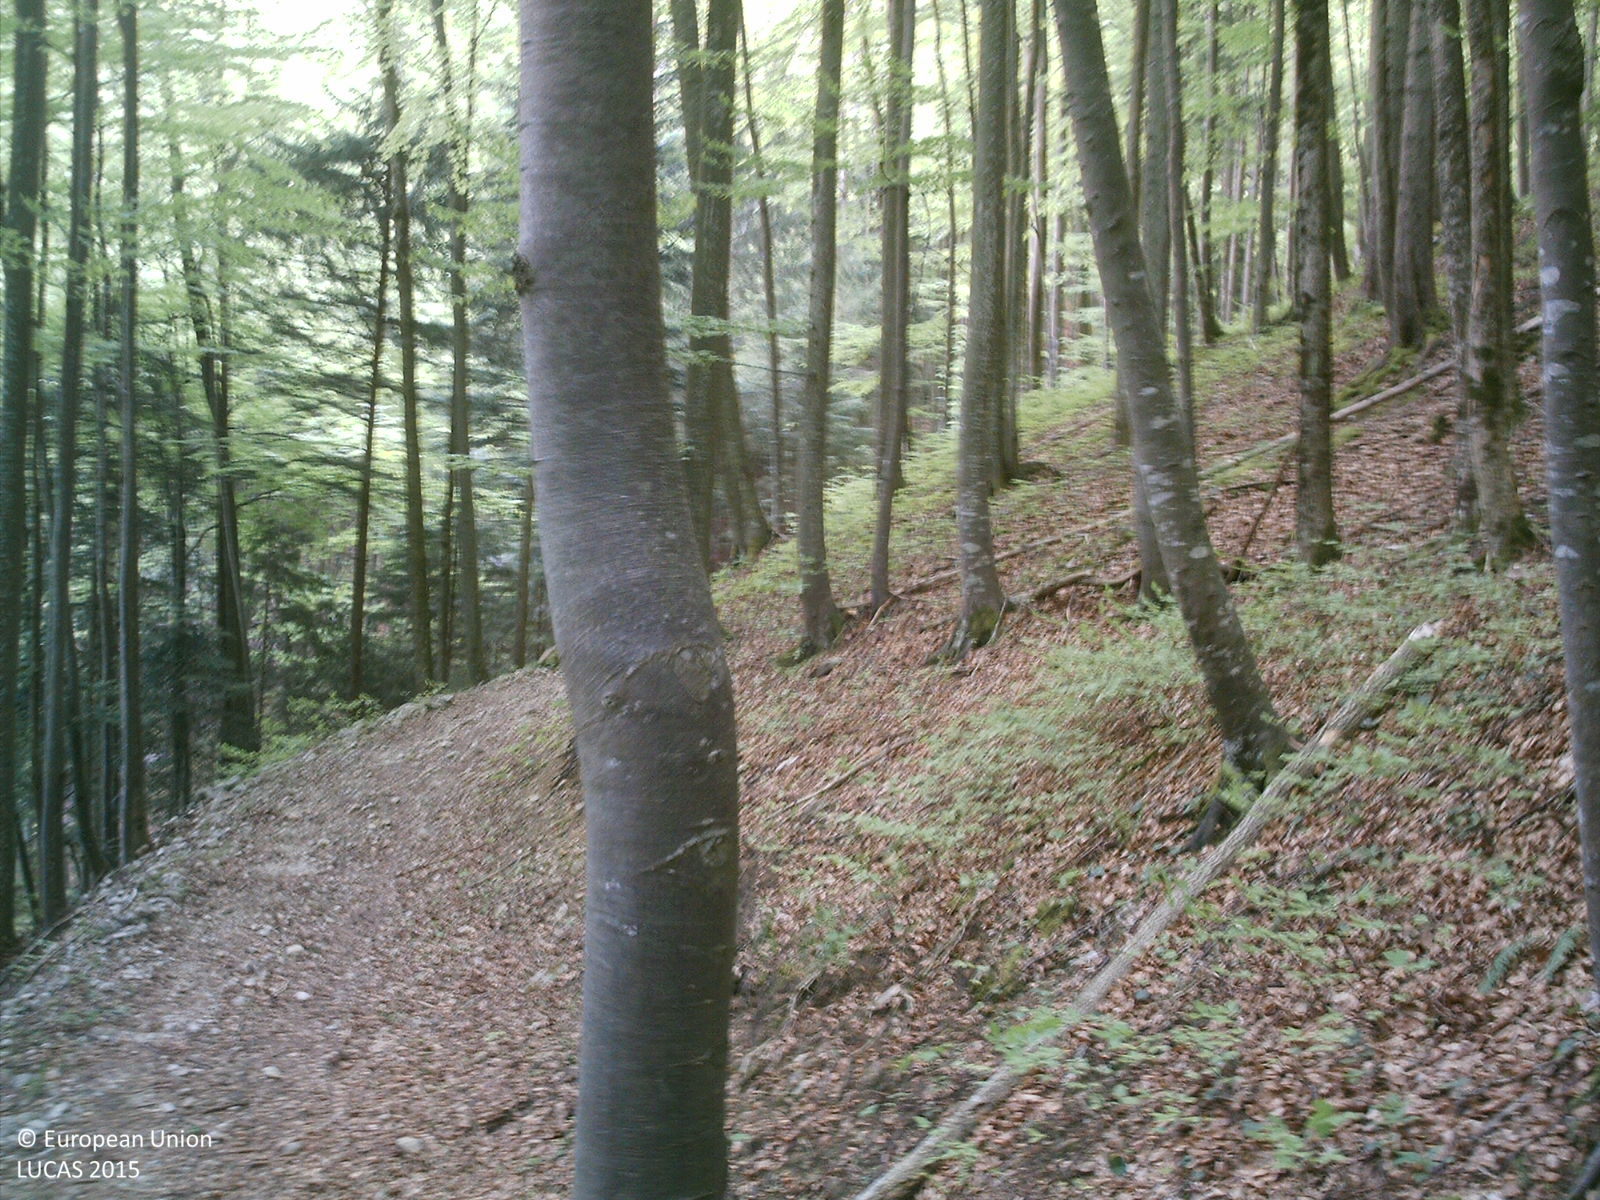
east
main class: Woodland
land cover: Other mixed woodland
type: mountainous beech forest
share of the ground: > 75 %
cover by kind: broadleaved forest trees 75 %, coniferous forest trees 25 %
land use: Forestry
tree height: > 5 m
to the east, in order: Other mixed woodland; Tracks; Rivers and streams; Tracks; Other mixed woodland; Tracks; Other mixed woodland; Tracks; Other mixed woodland; Spruce dominated coniferous woodland
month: May
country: AT
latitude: 47.8798
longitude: 14.0241
